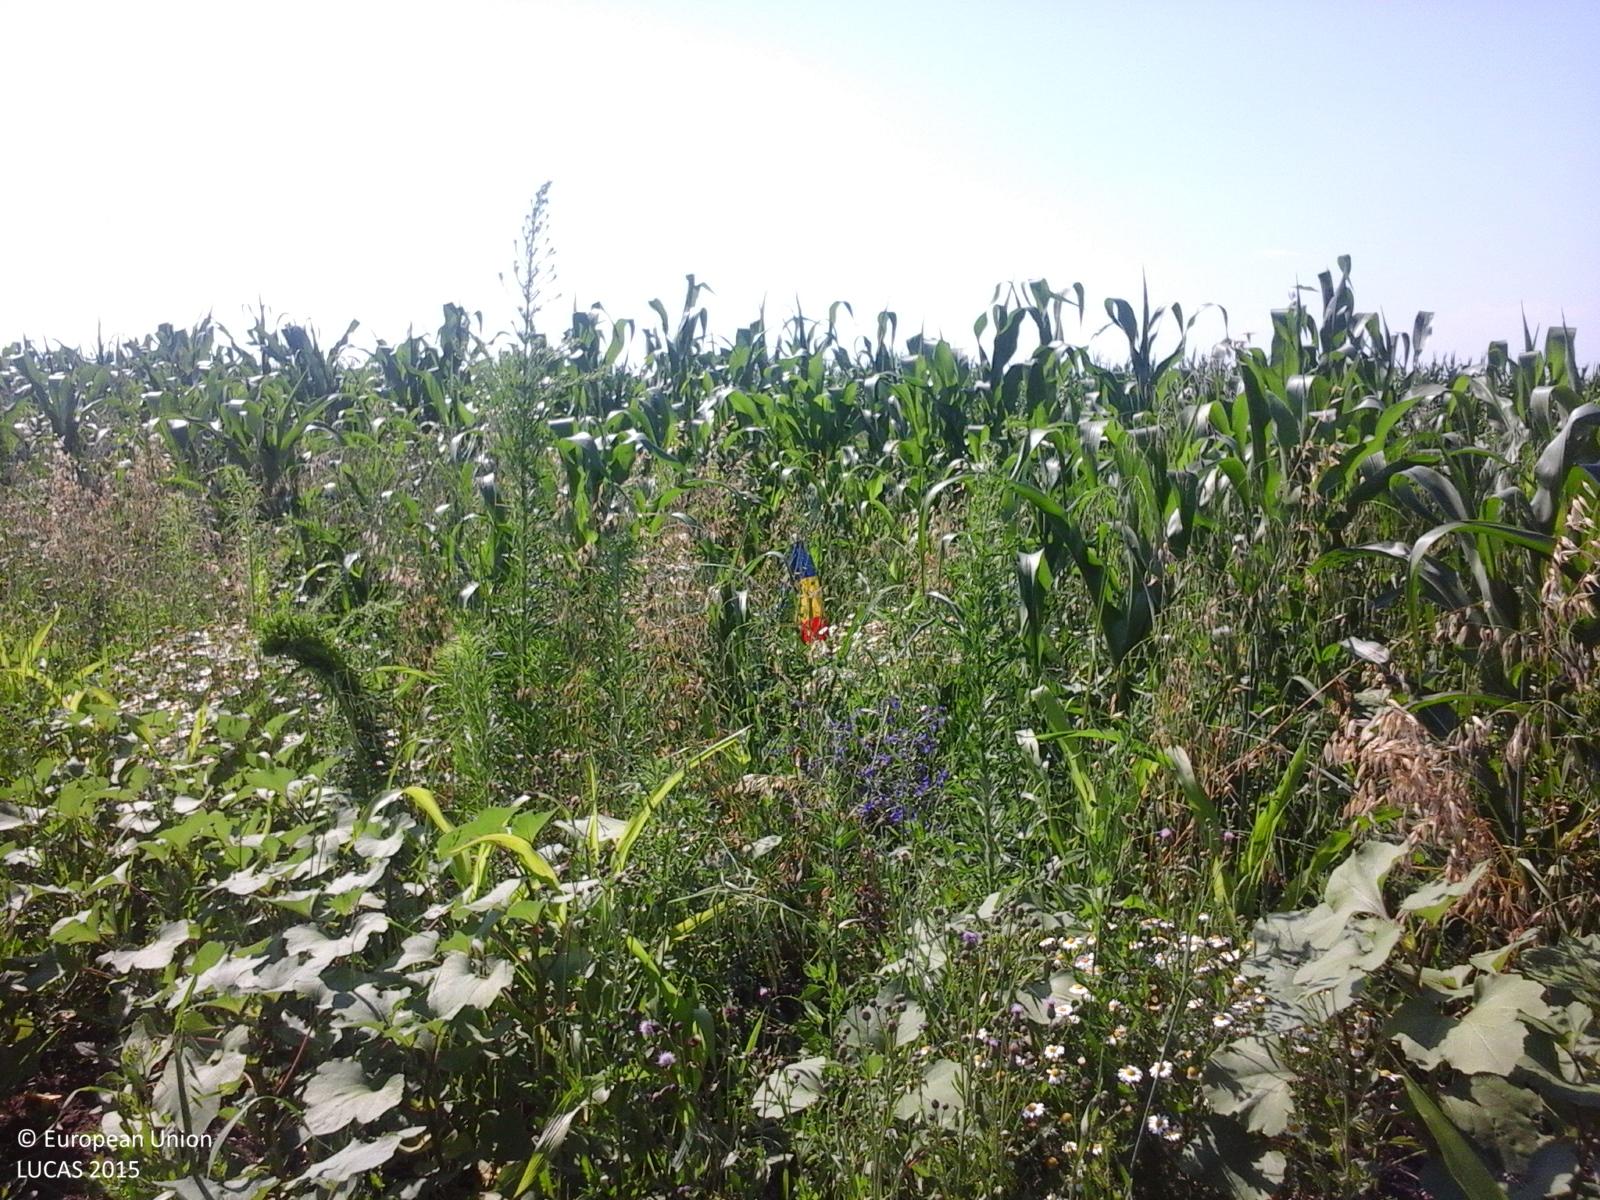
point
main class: Cropland
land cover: Maize
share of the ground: 50 - 75 %
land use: Agriculture (excluding fallow land and kitchen gardens)
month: July
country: RO
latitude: 44.5365
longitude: 24.6090
